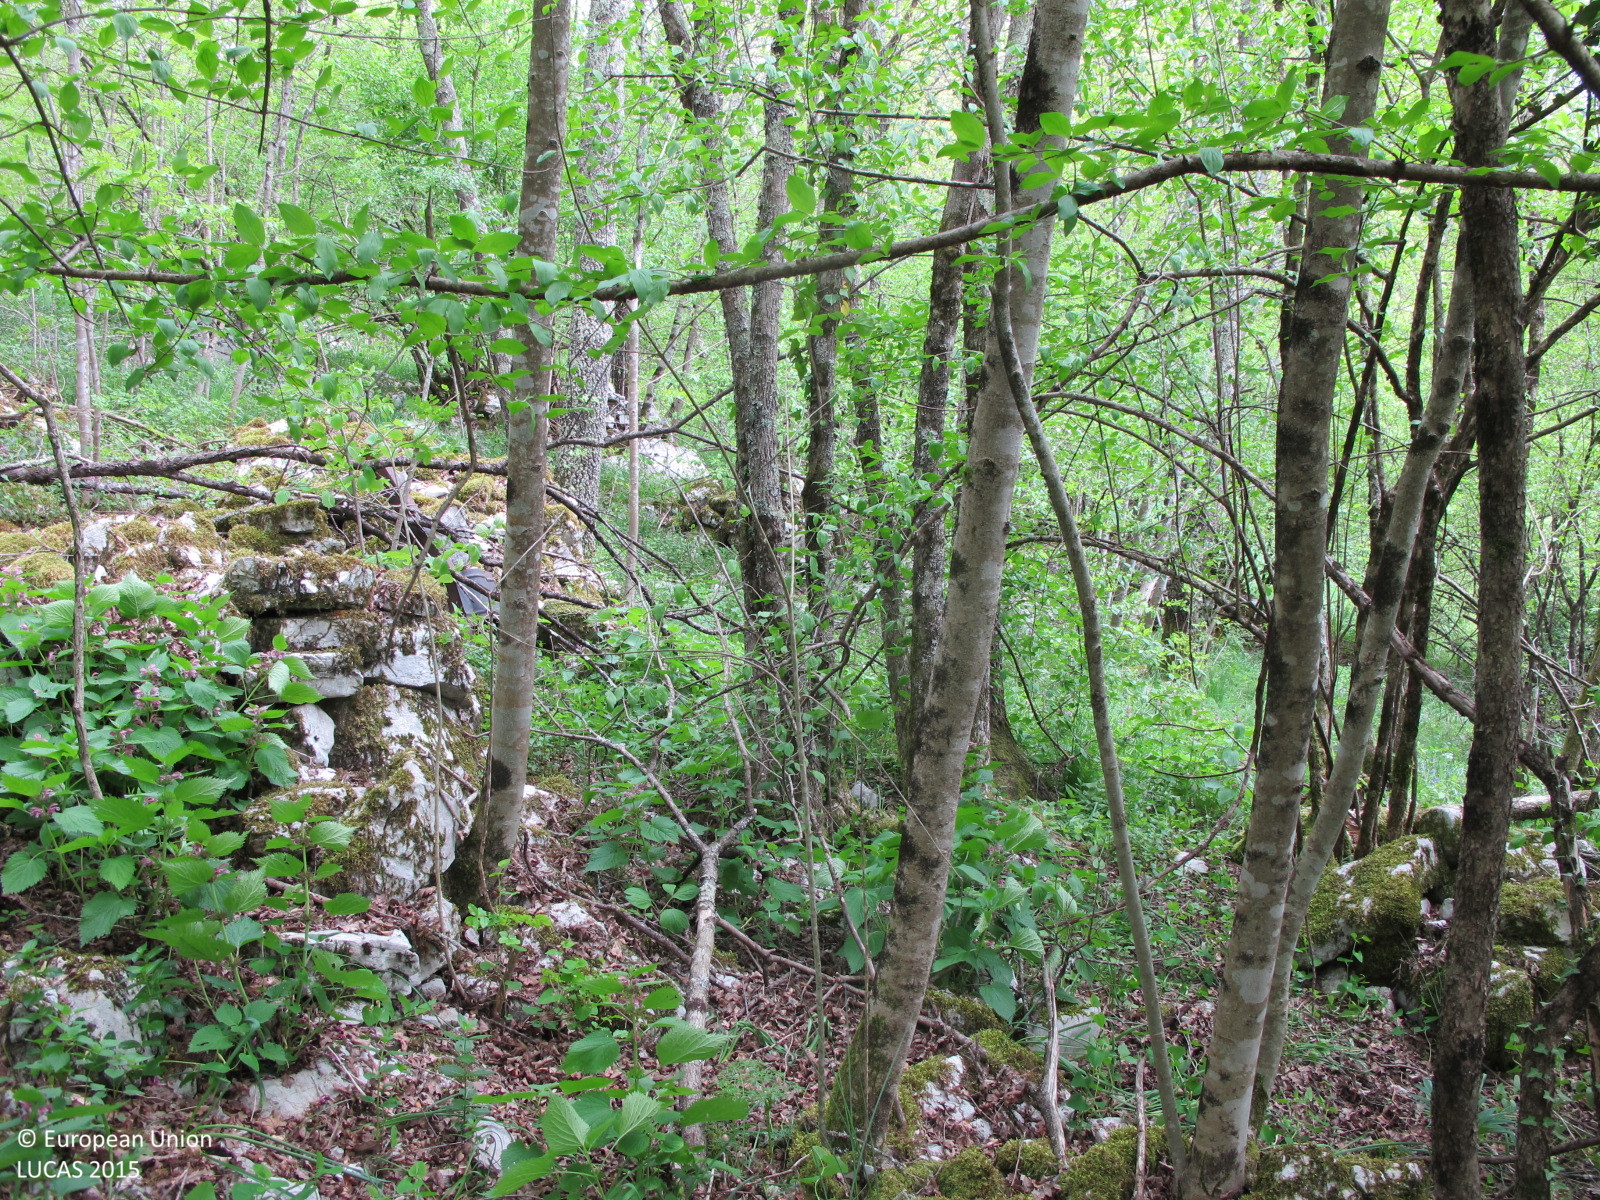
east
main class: Woodland
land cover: Broadleaved woodland
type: thermophilous deciduous forest
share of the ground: > 75 %
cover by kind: broadleaved forest trees 75 %, herbaceous plants 10 %, shrubs 5 %, consolidated bare surface 5 %
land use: Forestry
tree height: > 5 m
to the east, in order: Broadleaved woodland; Shrubland with sparse tree cover; Broadleaved woodland; Artificial constructions in urban areas
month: May
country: HR
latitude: 45.4178
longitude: 14.2761
